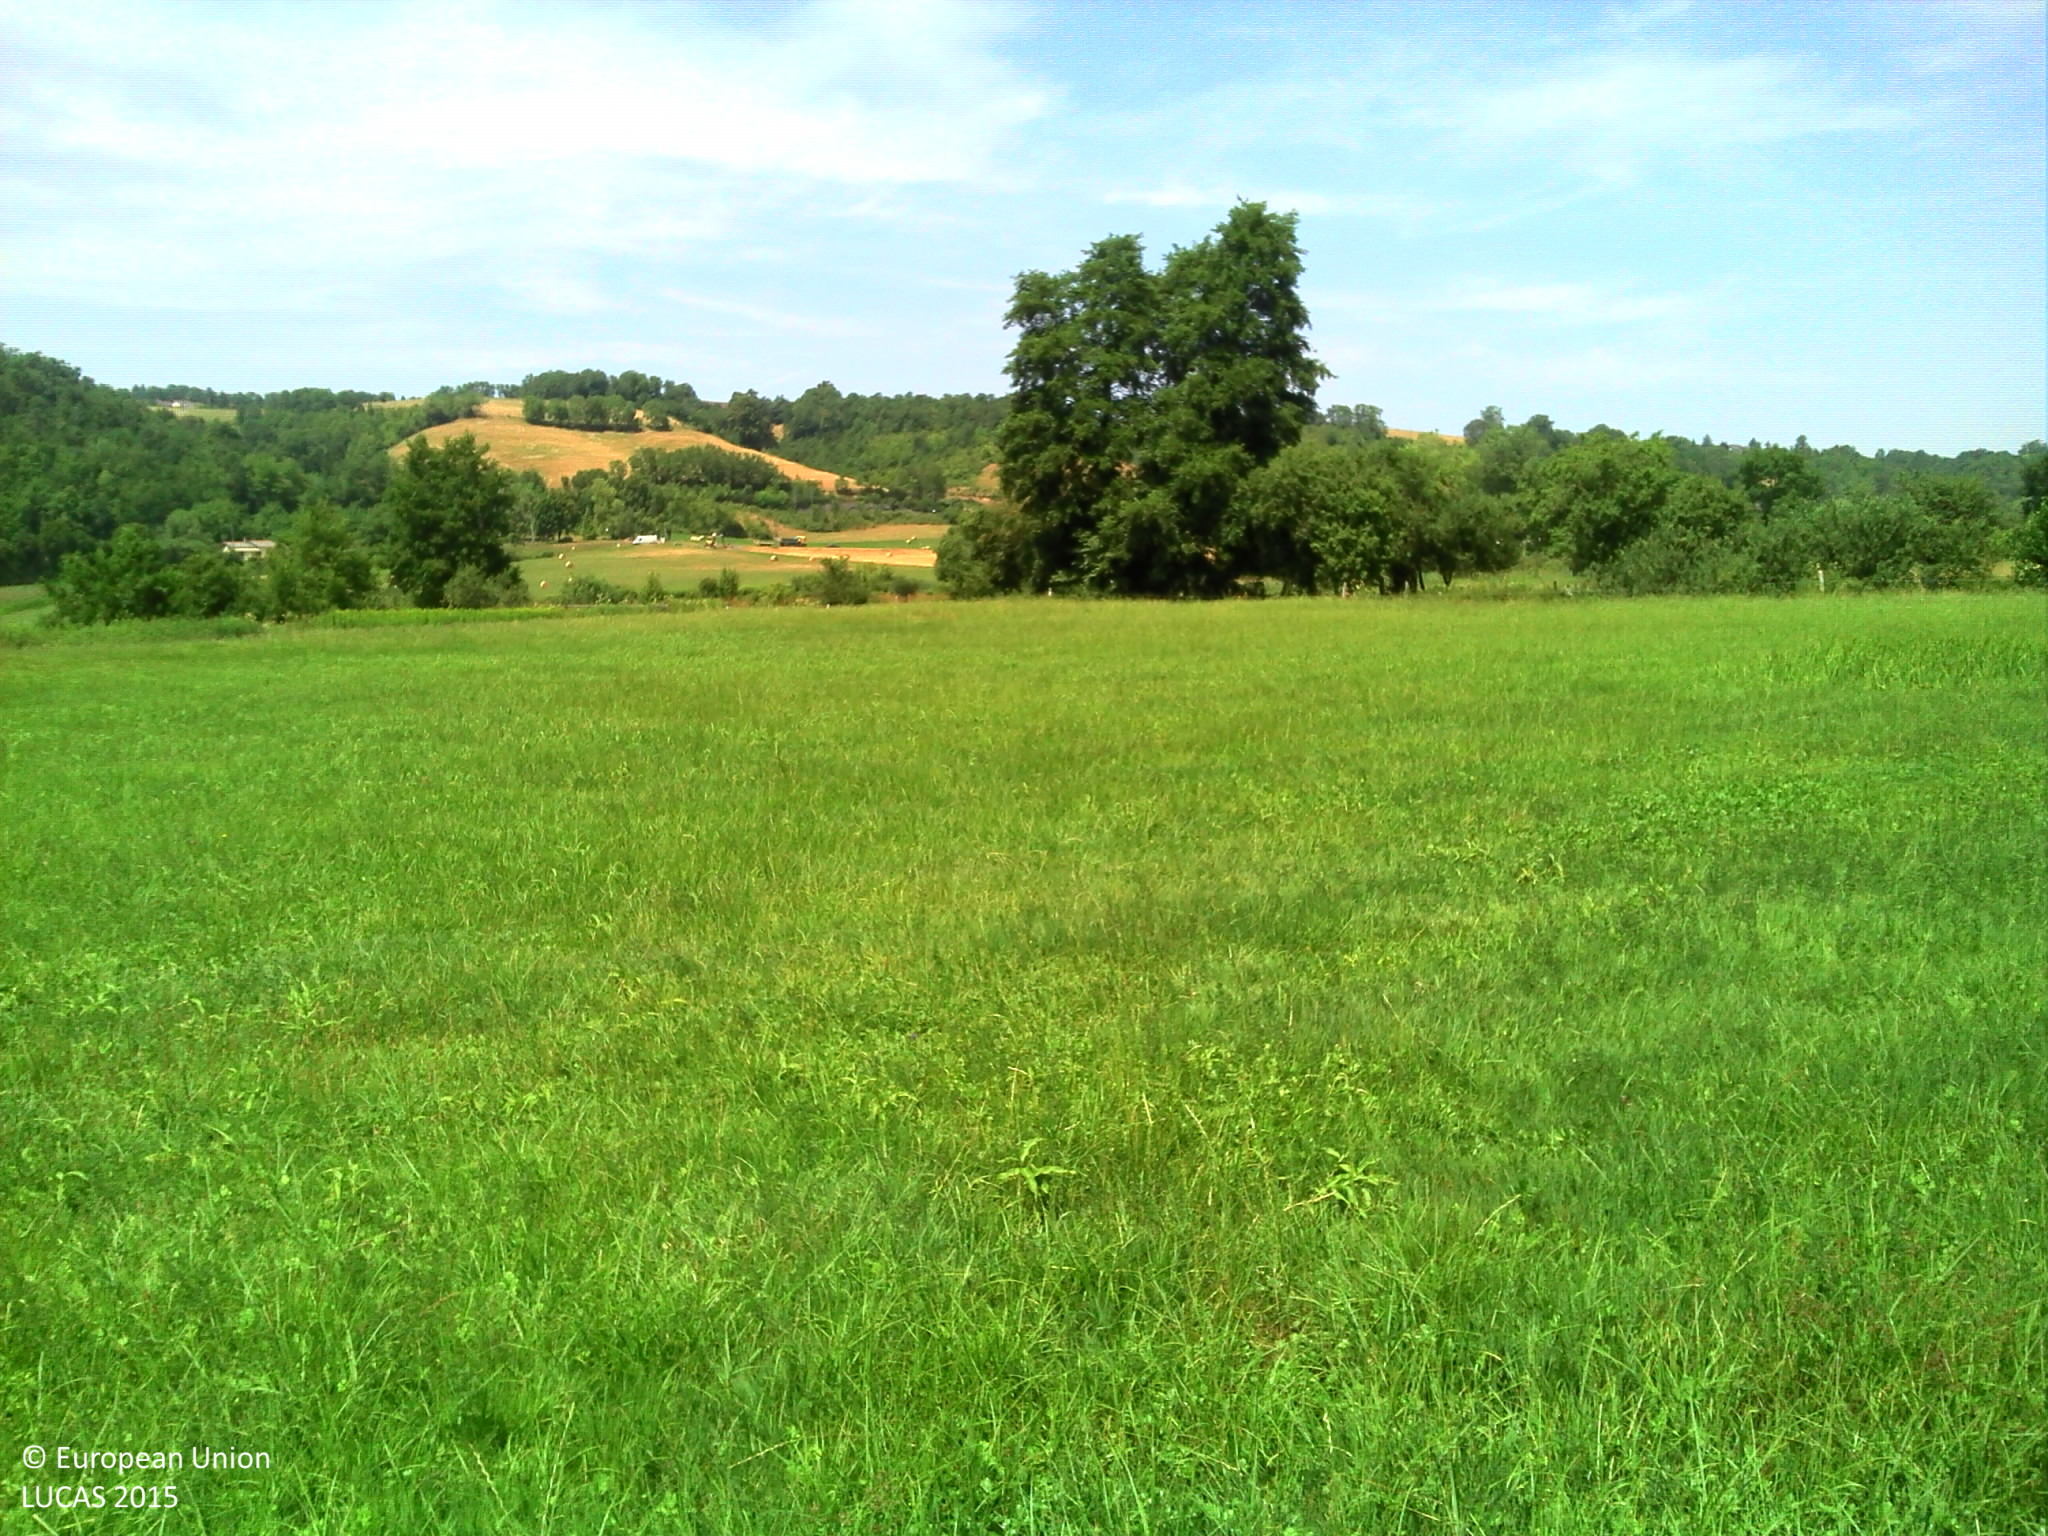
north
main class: Grassland
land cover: Grassland without tree/shrub cover
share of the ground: > 75 %
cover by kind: herbaceous plants 100 %
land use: Agriculture (excluding fallow land and kitchen gardens)
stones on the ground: < 10 %
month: July
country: FR
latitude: 45.4791
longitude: 5.4632
